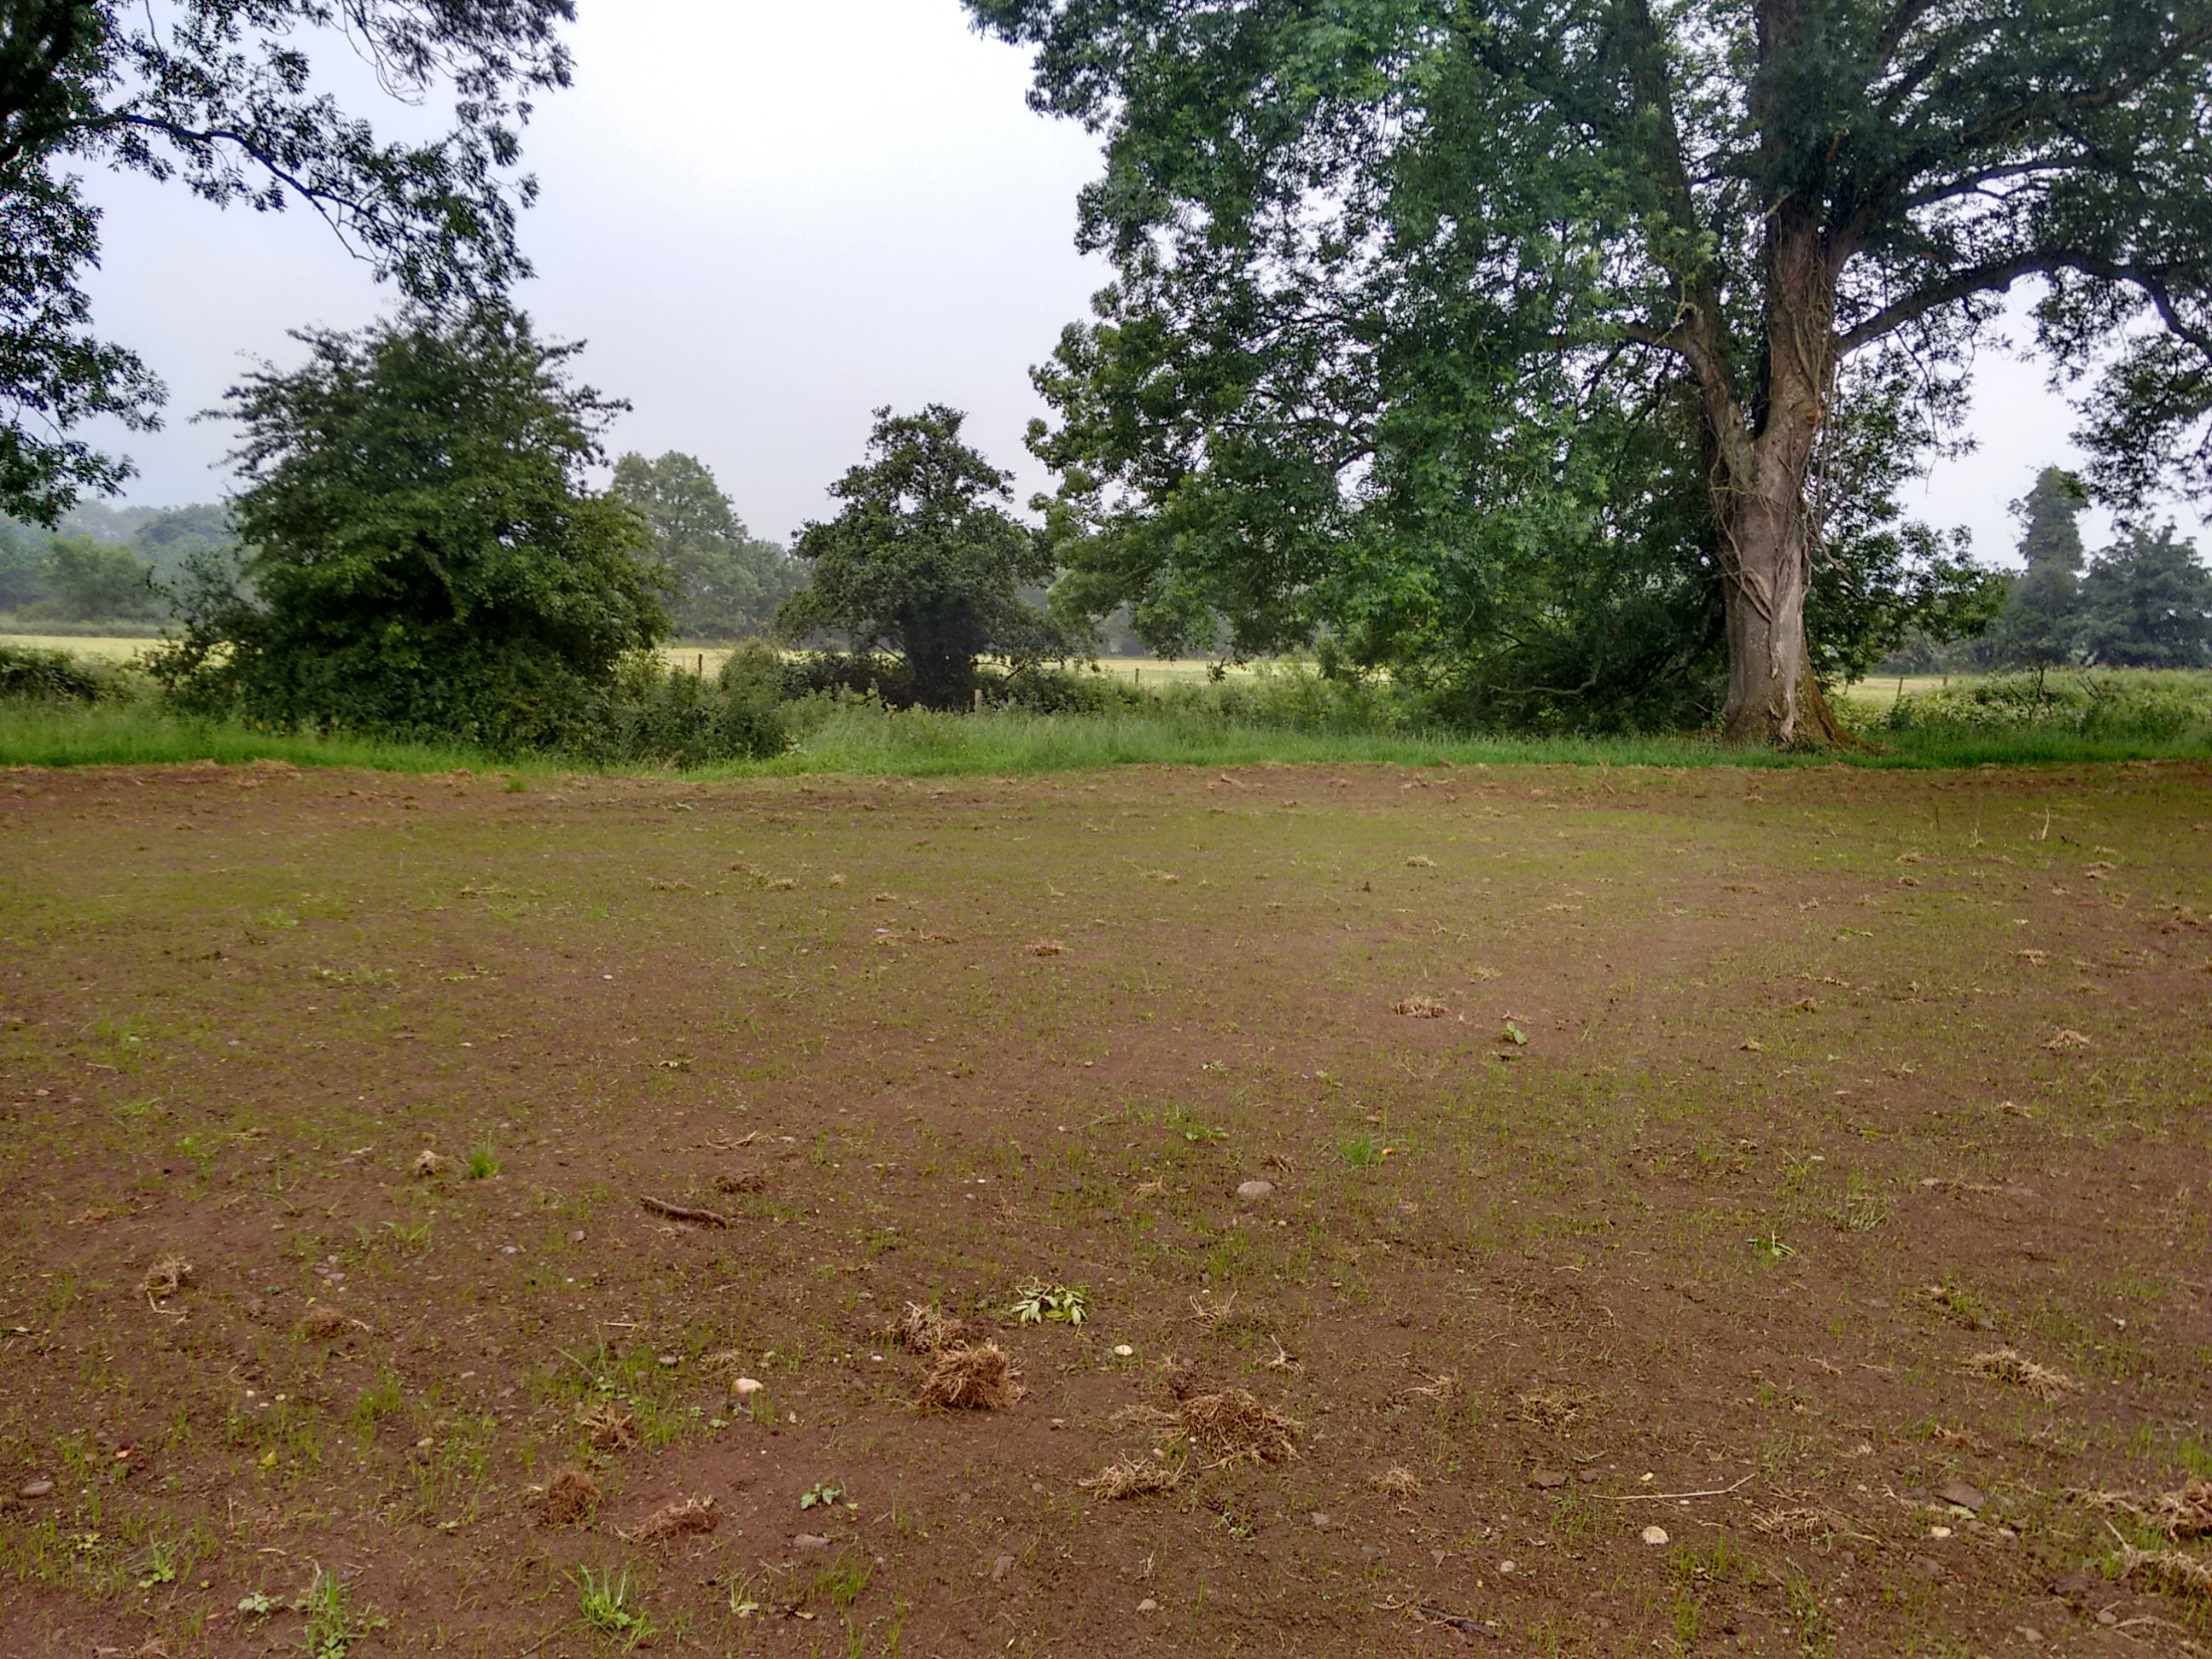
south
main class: Cropland
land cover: Temporary grasslands
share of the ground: < 10 %
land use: Agriculture (excluding fallow land and kitchen gardens)
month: July
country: GB
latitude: 54.4303
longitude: -7.1473
